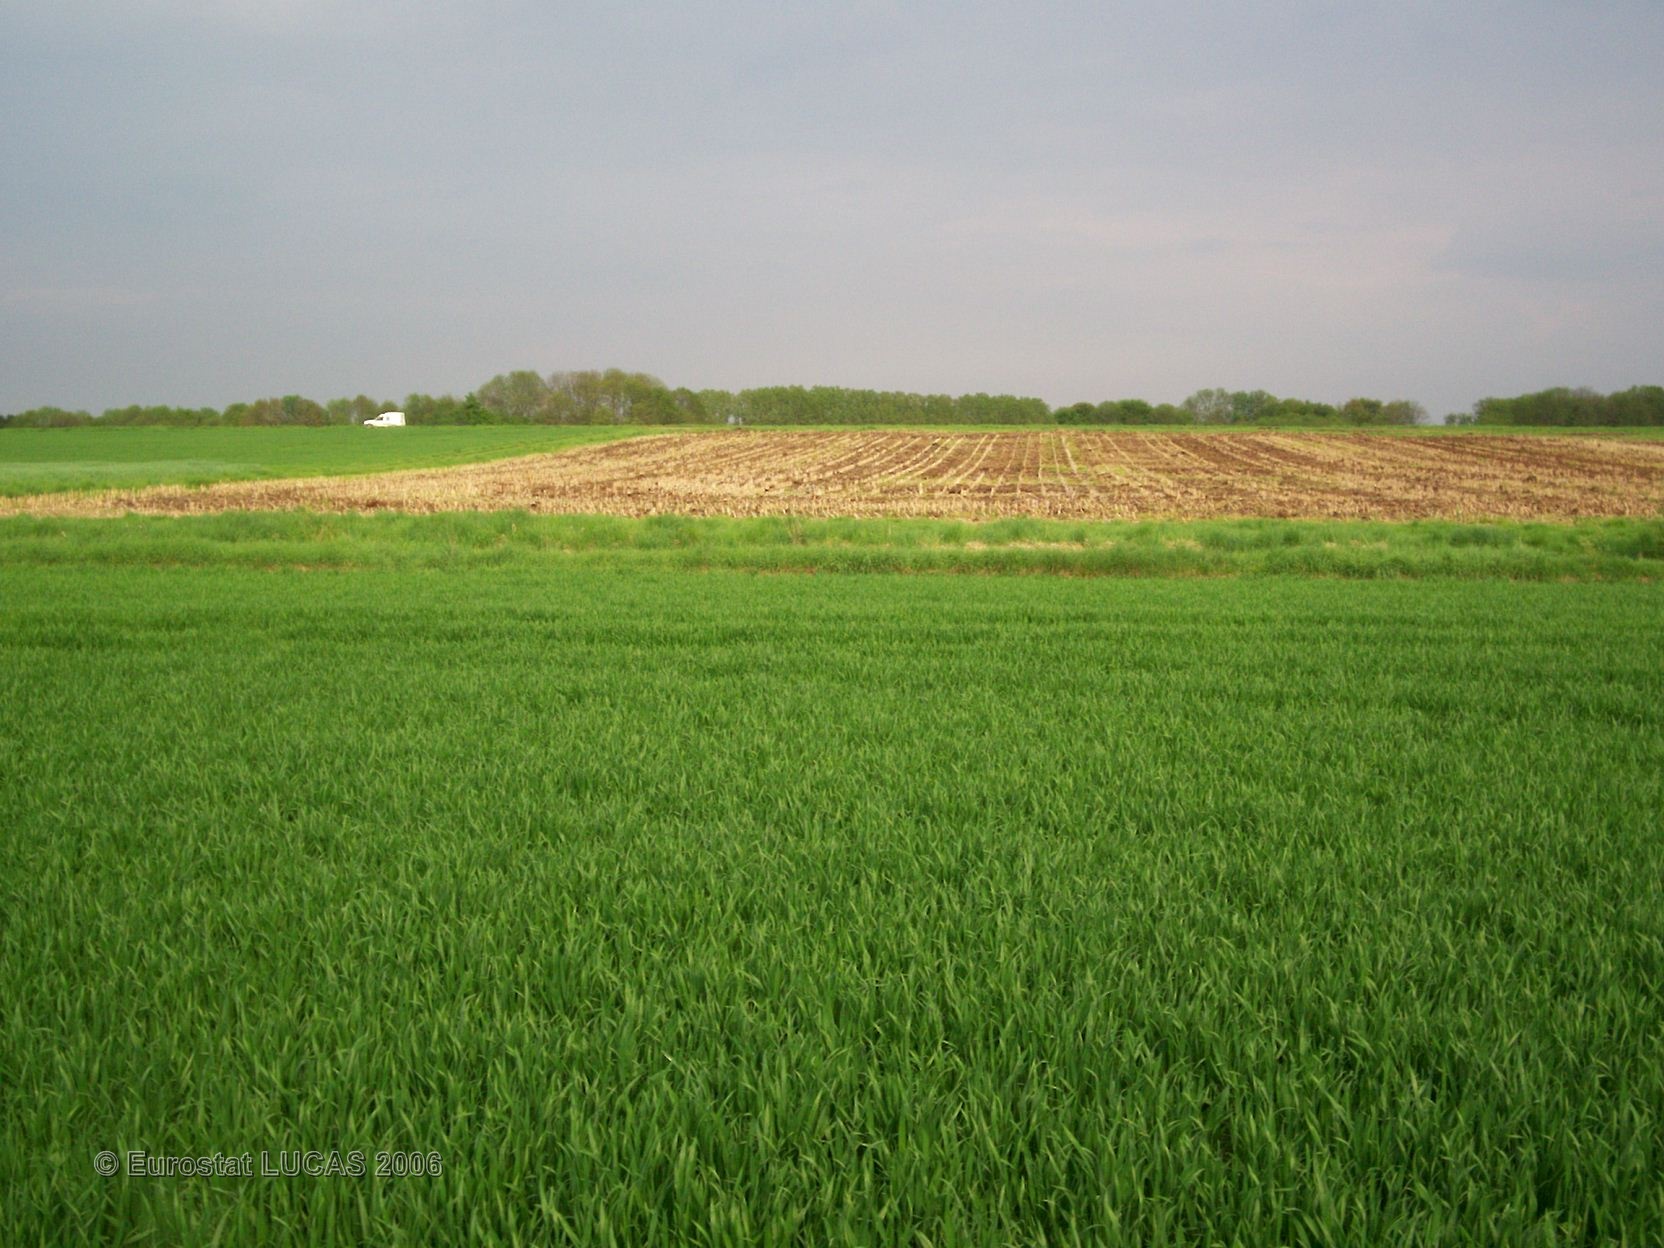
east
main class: Cropland
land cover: Common wheat
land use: Agriculture (excluding fallow land and kitchen gardens)
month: May
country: FR
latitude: 47.5736
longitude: 7.1169
